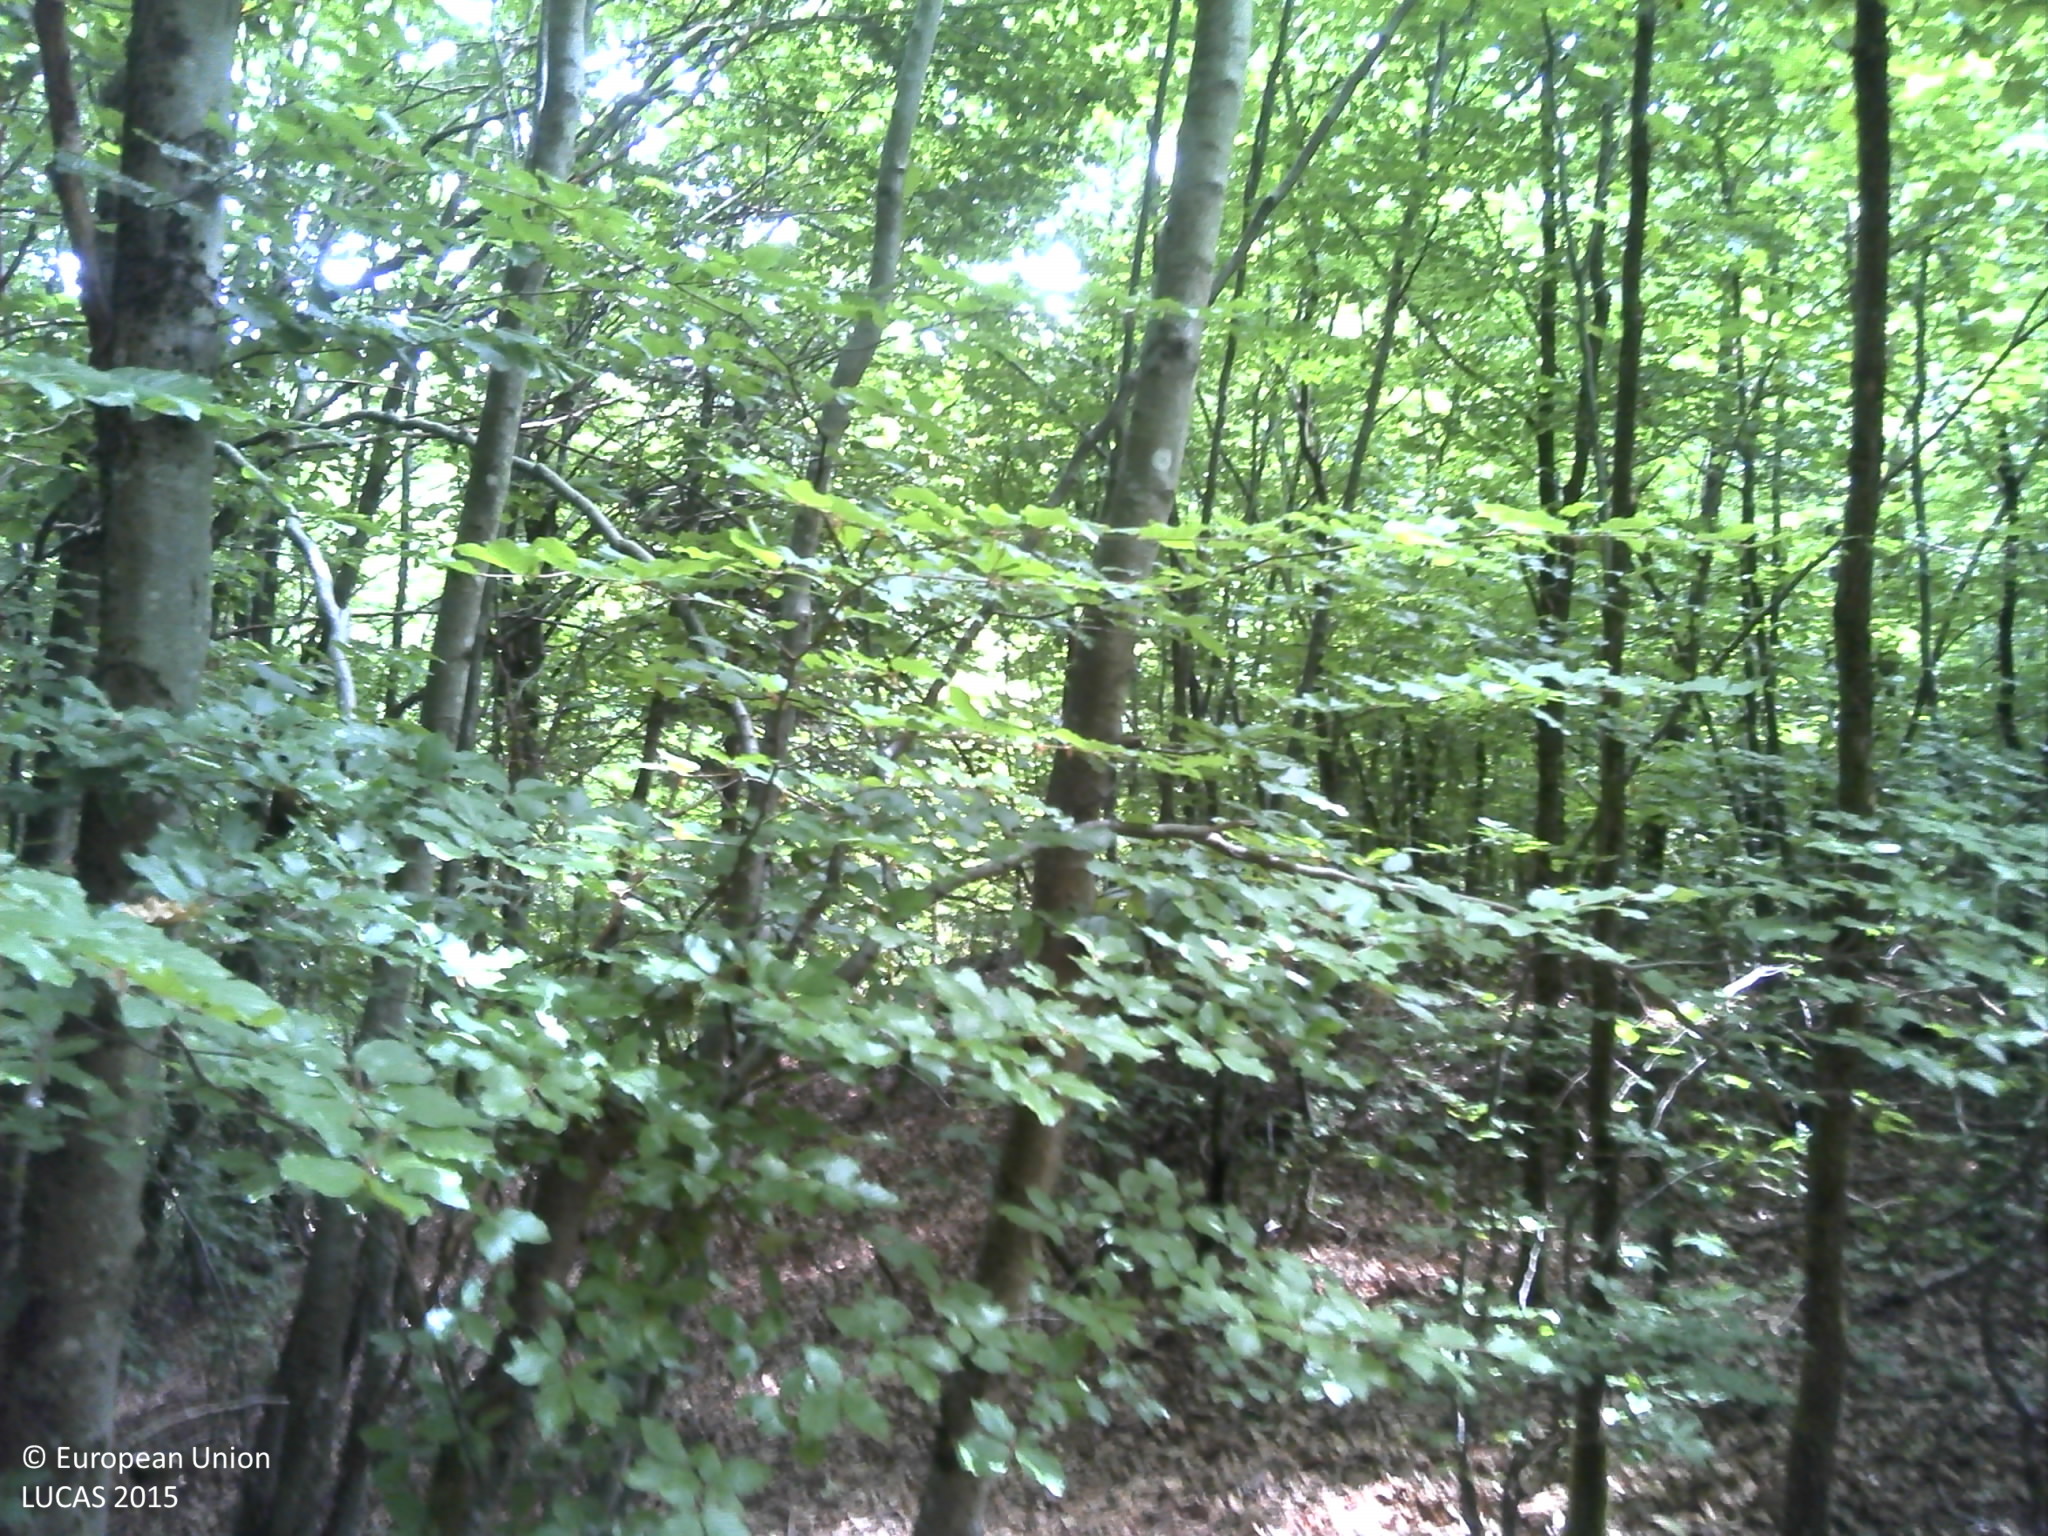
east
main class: Woodland
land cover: Broadleaved woodland
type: acidophilous oak and oak-birch forest
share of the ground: > 75 %
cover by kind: broadleaved forest trees 95 %, lichens and mosses 5 %
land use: Forestry
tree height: > 5 m
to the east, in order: Broadleaved woodland; Rock outcrops; Grass margins; Paved roads, cycling and walking lanes; Grass margins; Lines of trees; Grassland without tree/shrub cover; Rivers and streams; Other mixed woodland; Broadleaved woodland; Tracks; Broadleaved woodland; Tracks; Broadleaved woodland
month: July
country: FR
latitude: 49.0040
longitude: 7.4443
